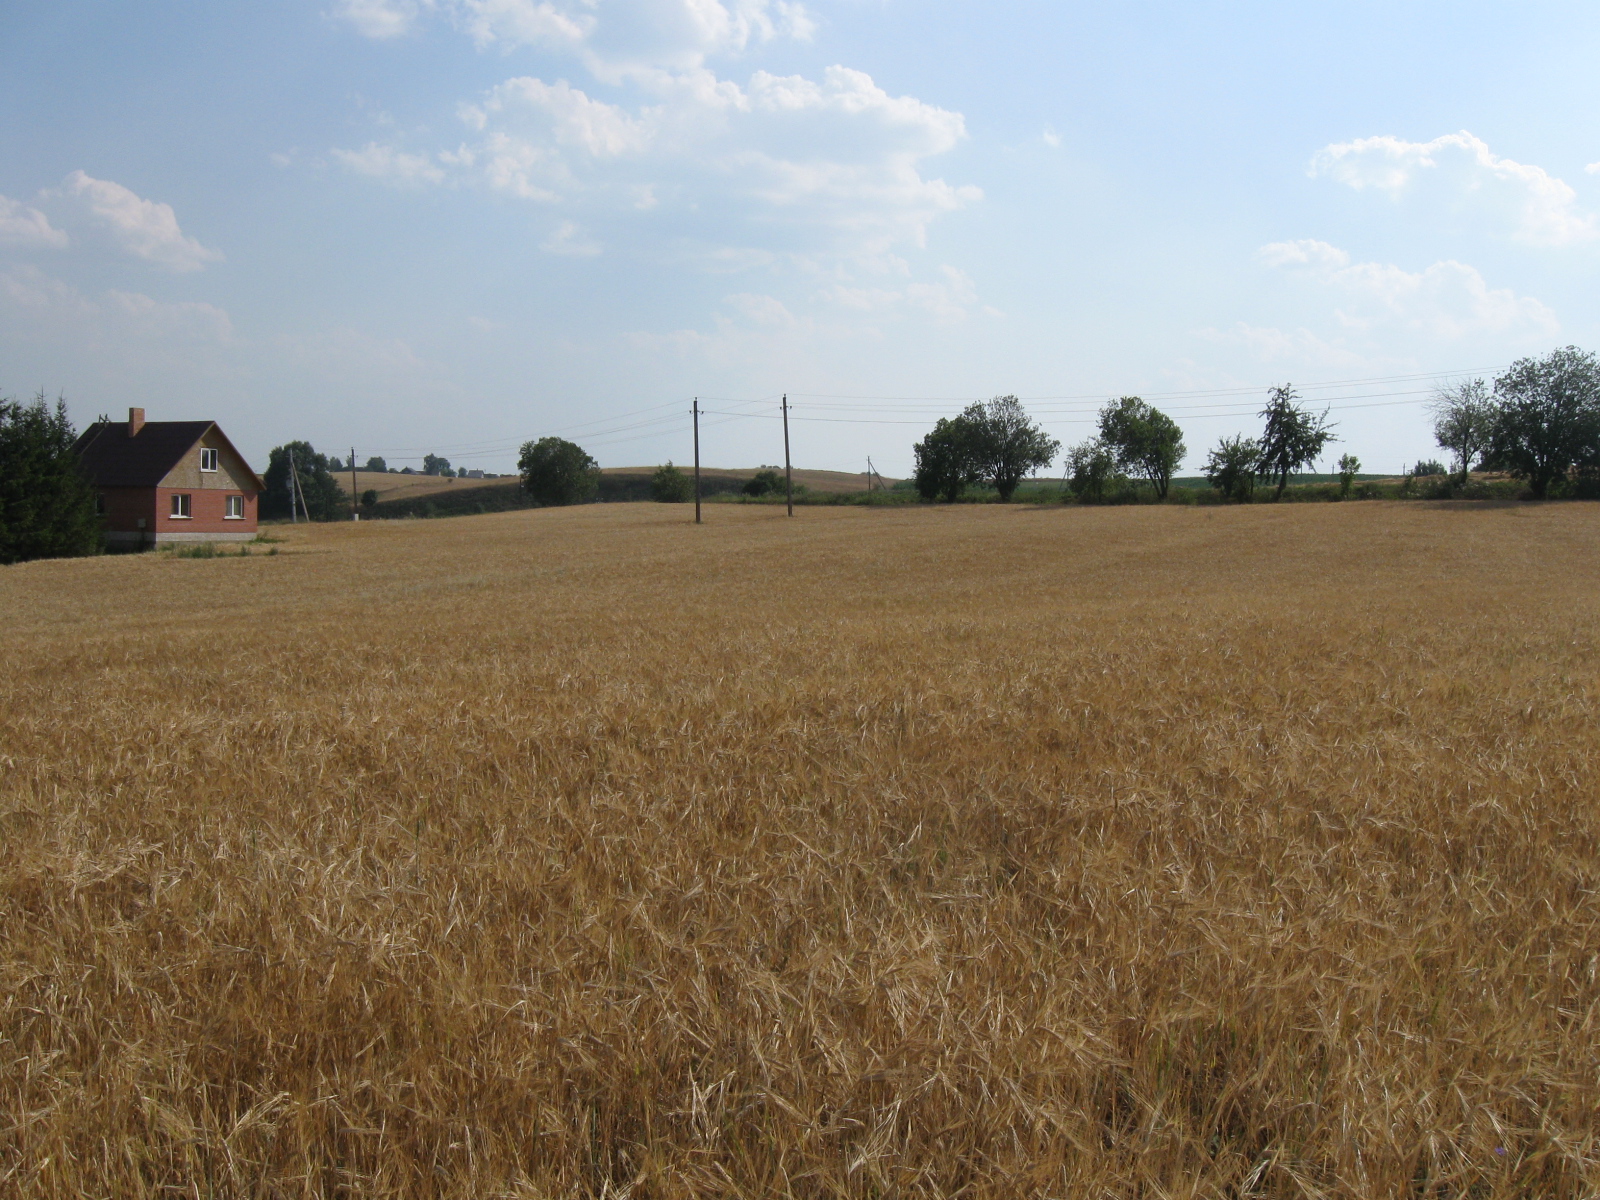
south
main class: Cropland
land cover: Barley
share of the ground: > 75 %
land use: Agriculture (excluding fallow land and kitchen gardens)
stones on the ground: < 10 %
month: August
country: LT
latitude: 54.4198
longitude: 23.2539
